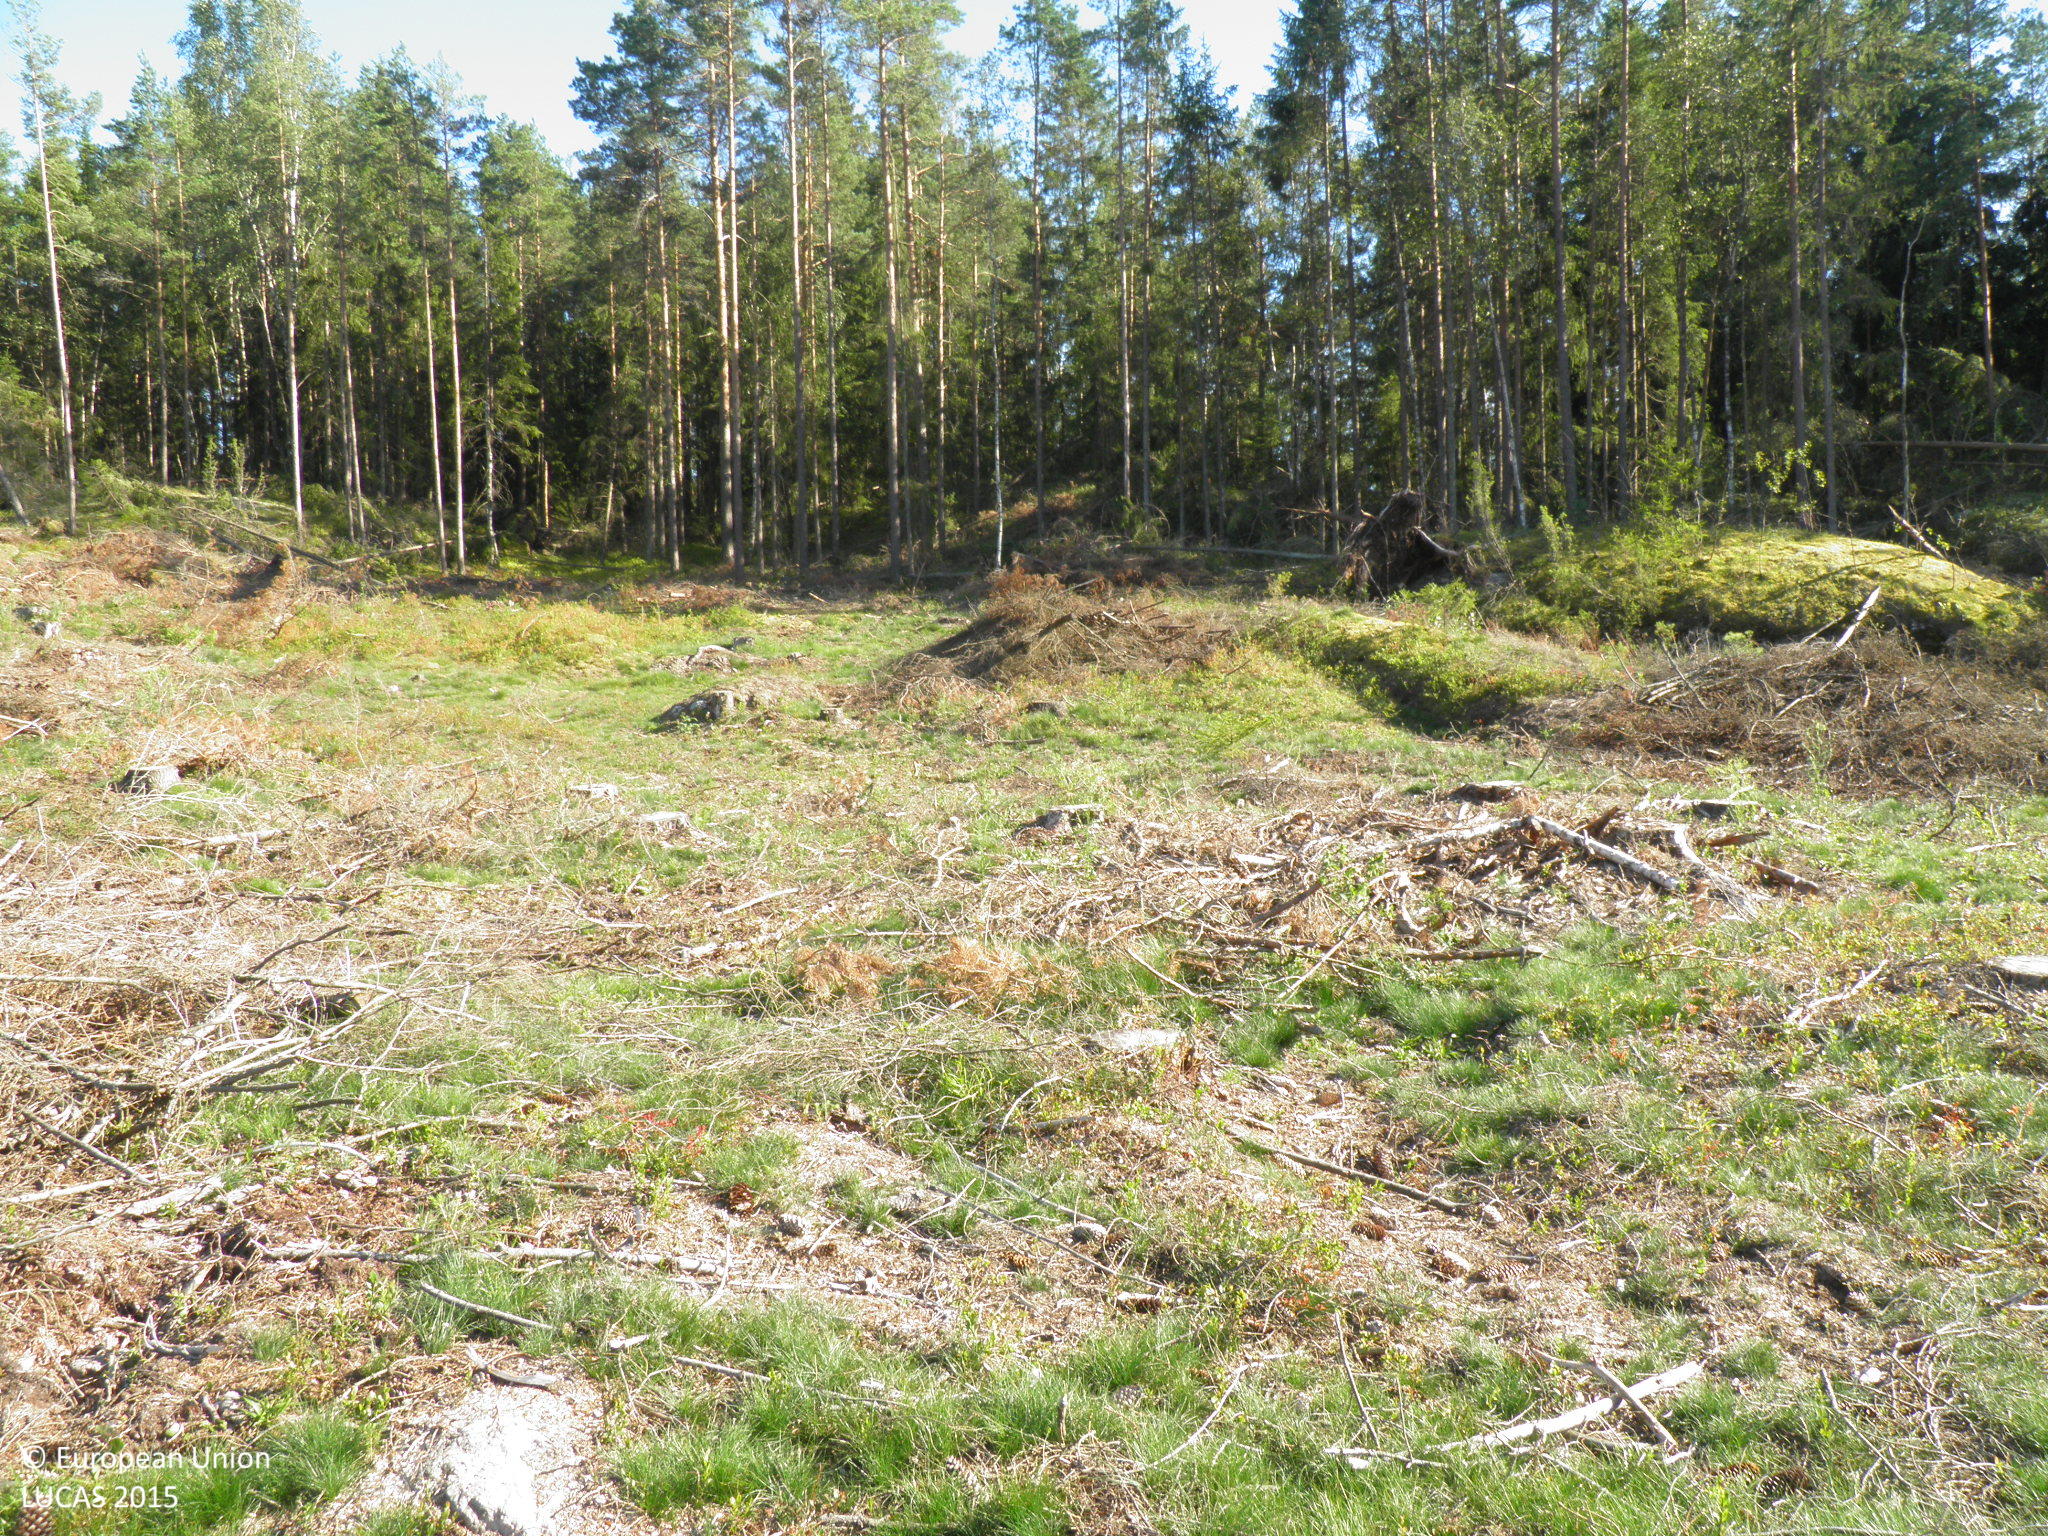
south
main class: Grassland
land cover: Spontaneously vegetated surfaces
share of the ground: 10 - 25 %
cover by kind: unconsolidated bare surface 40 %, herbaceous plants 15 %, shrubs 5 %
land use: Forestry
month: August
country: FI
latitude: 60.7103
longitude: 21.7309
